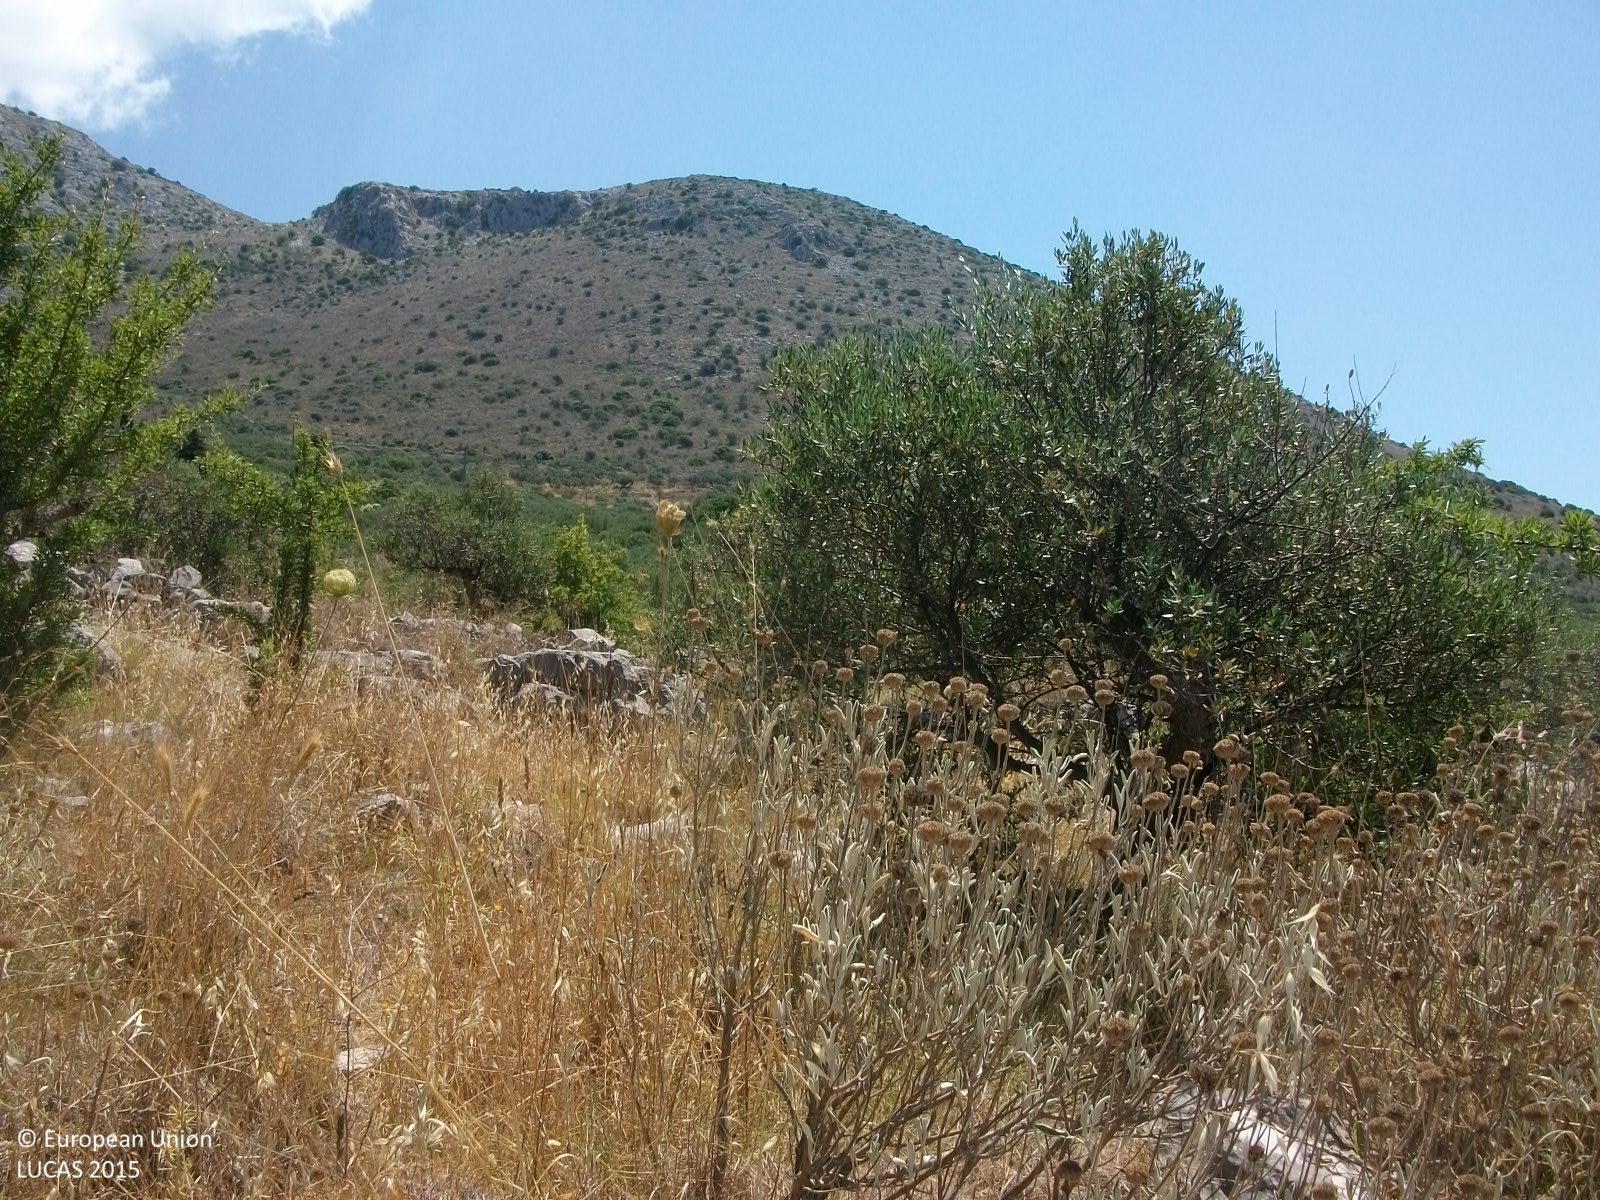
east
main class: Cropland
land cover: Olive groves
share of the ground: 25 - 50 %
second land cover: Spontaneously vegetated surfaces
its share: > 75 %
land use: Agriculture (excluding fallow land and kitchen gardens)
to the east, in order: Olive groves; Spontaneously vegetated surfaces; Dry stone walls; Olive groves; Dry stone walls; Olive groves; Dry stone walls; Olive groves; Dry stone walls; Olive groves; Dry stone walls; Olive groves; Electric lines; Olive groves; Dry stone walls; Olive groves; Dry stone walls; Olive groves; Dry stone walls; Olive groves; Dry stone walls; Olive groves; Electric lines; Dry stone walls; Grass margins; Paved roads, cycling and walking lanes; Electric lines; Grass margins; Dry stone walls; Olive groves; Dry stone walls; Olive groves; Dry stone walls; Olive groves; Dry stone walls; Olive groves; Dry stone walls; Olive groves
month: July
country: GR
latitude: 36.7170
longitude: 22.3663
